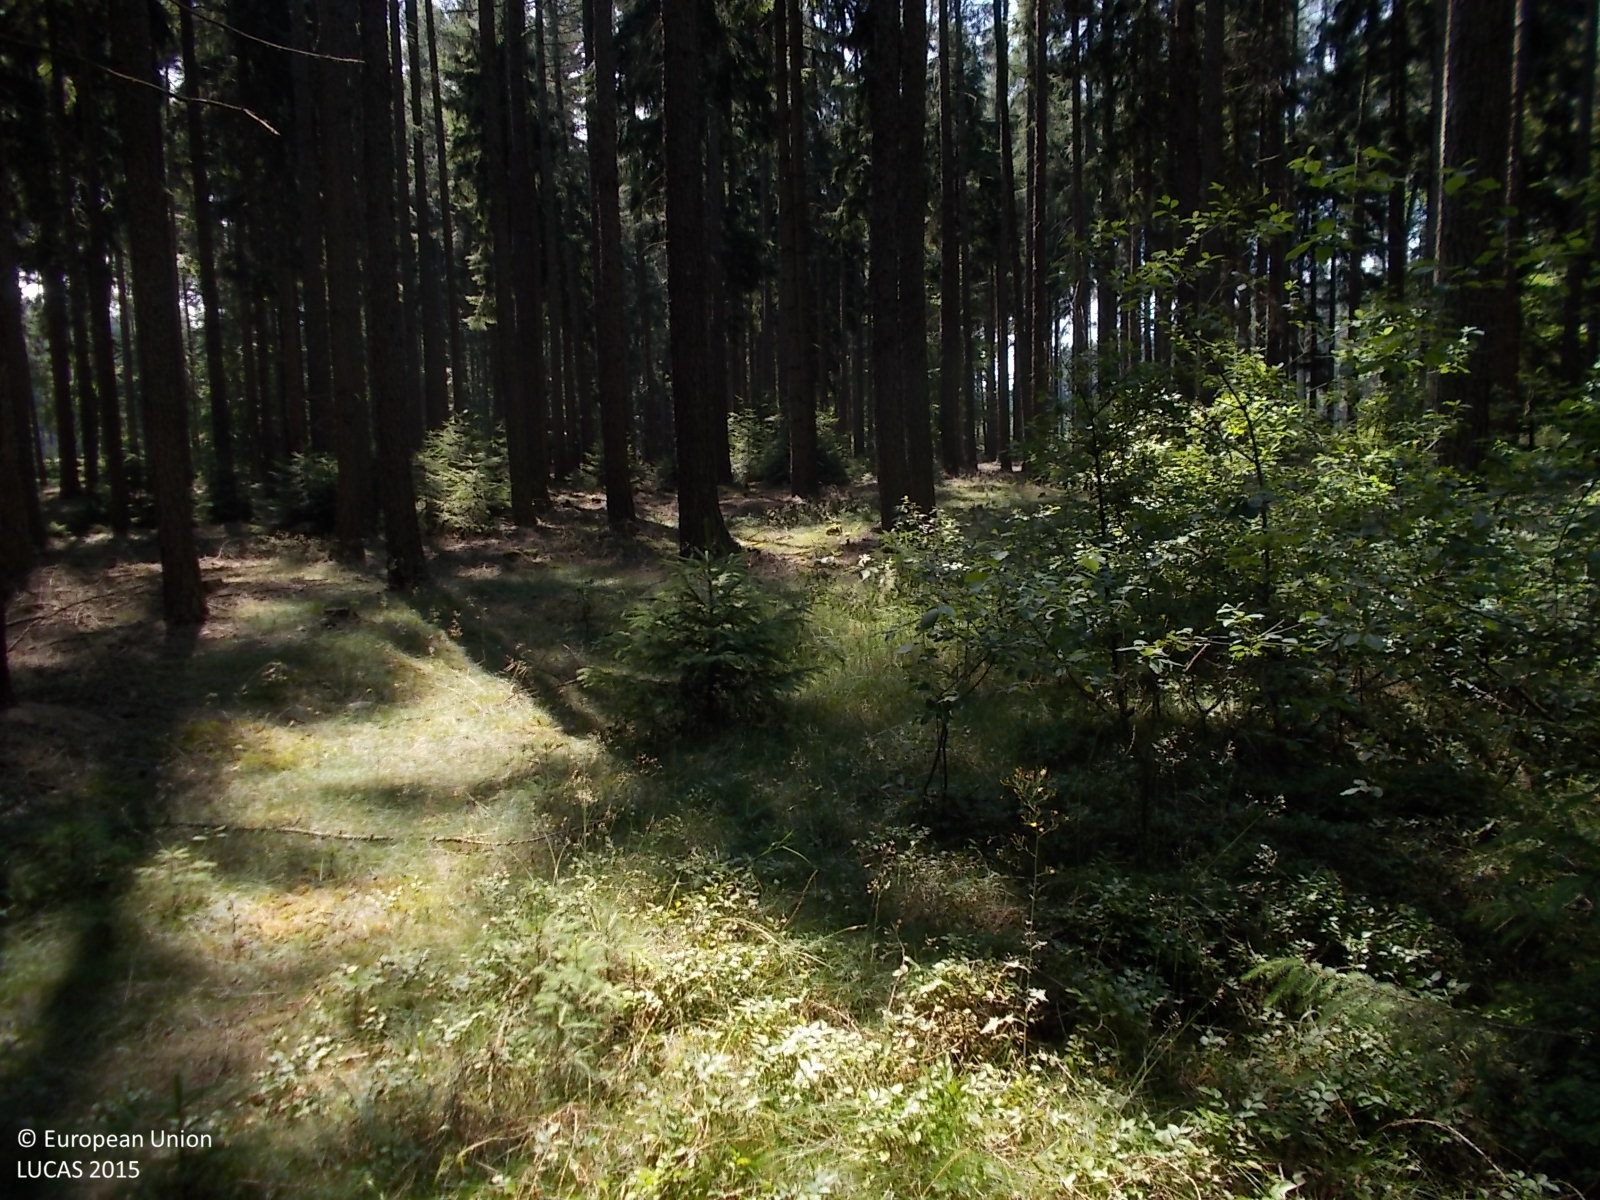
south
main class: Woodland
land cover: Other coniferous woodland
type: hemiboreal forest and nemoral coniferous forest and mixed broadleaved-coniferous forest
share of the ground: > 75 %
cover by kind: coniferous forest trees 75 %, herbaceous plants 10 %, lichens and mosses 10 %, shrubs 5 %
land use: Forestry
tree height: > 5 m
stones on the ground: < 10 %
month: July
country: CZ
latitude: 50.2110
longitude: 13.7981
